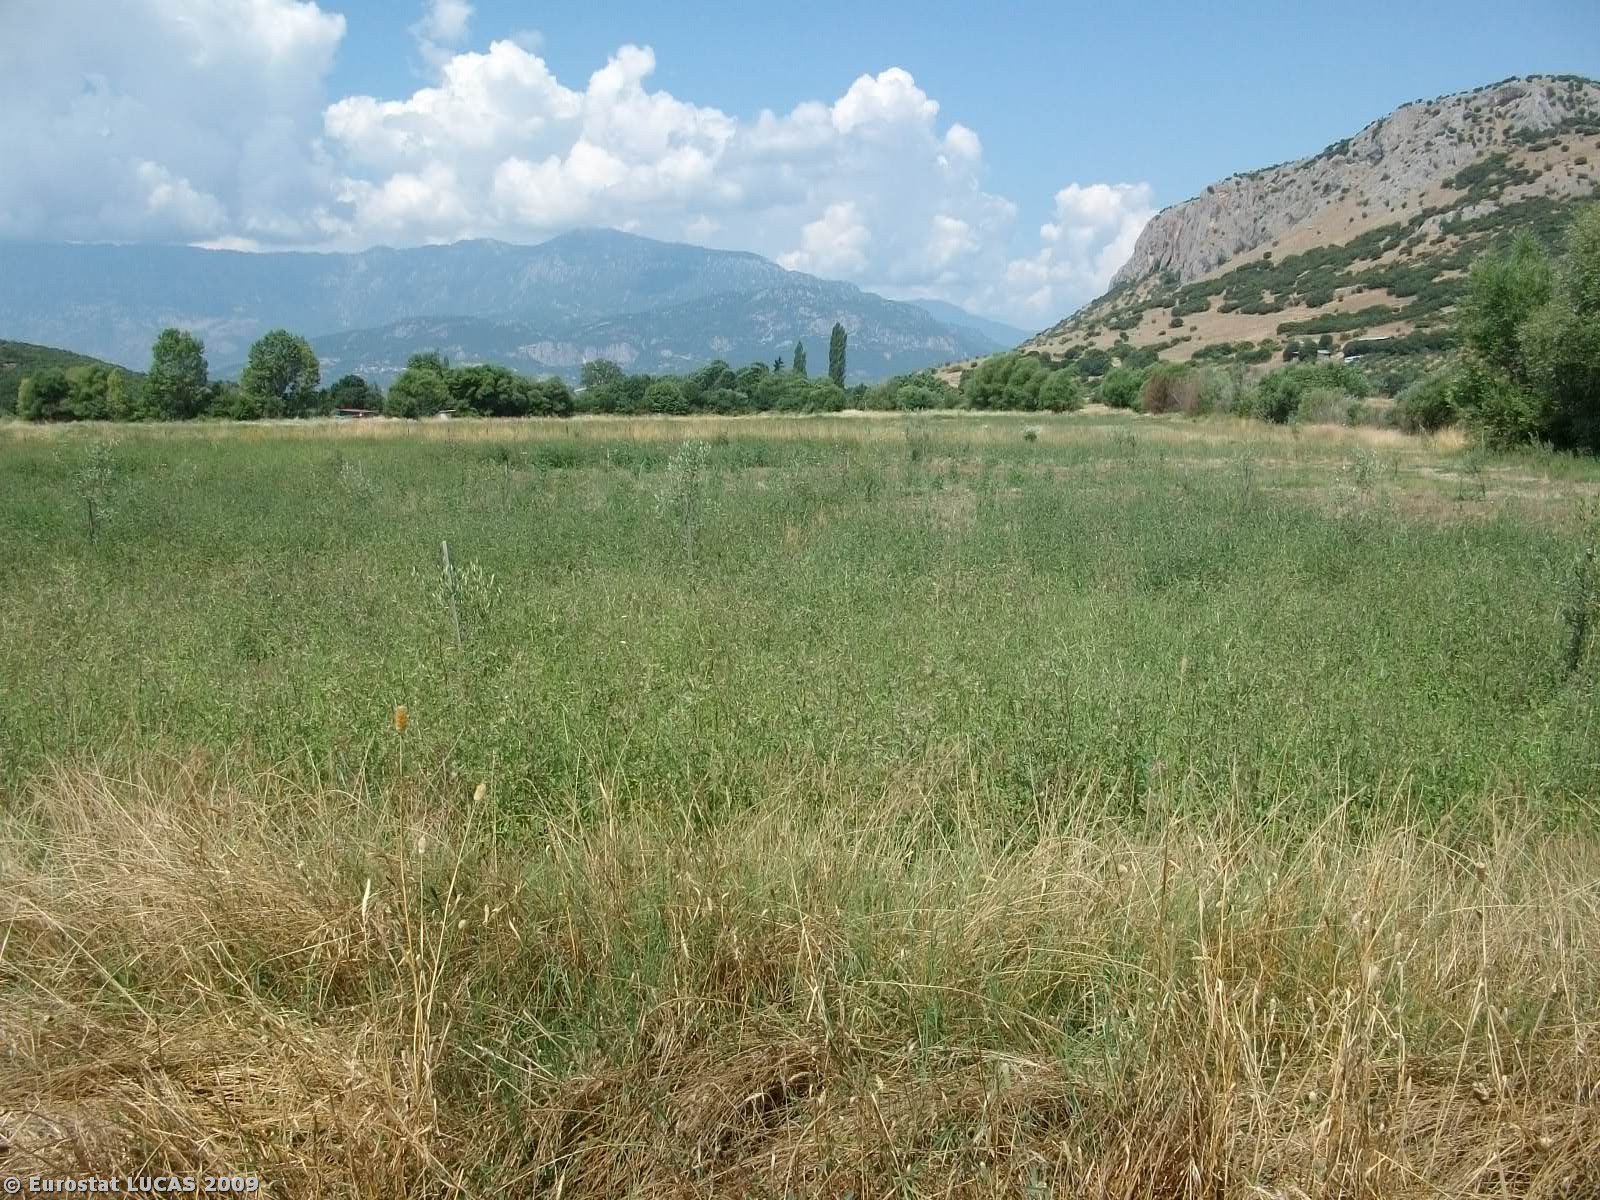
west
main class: Cropland
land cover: Common wheat
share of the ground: > 75 %
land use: Agriculture (excluding fallow land and kitchen gardens)
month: July
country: GR
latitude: 39.6743
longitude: 21.7006
